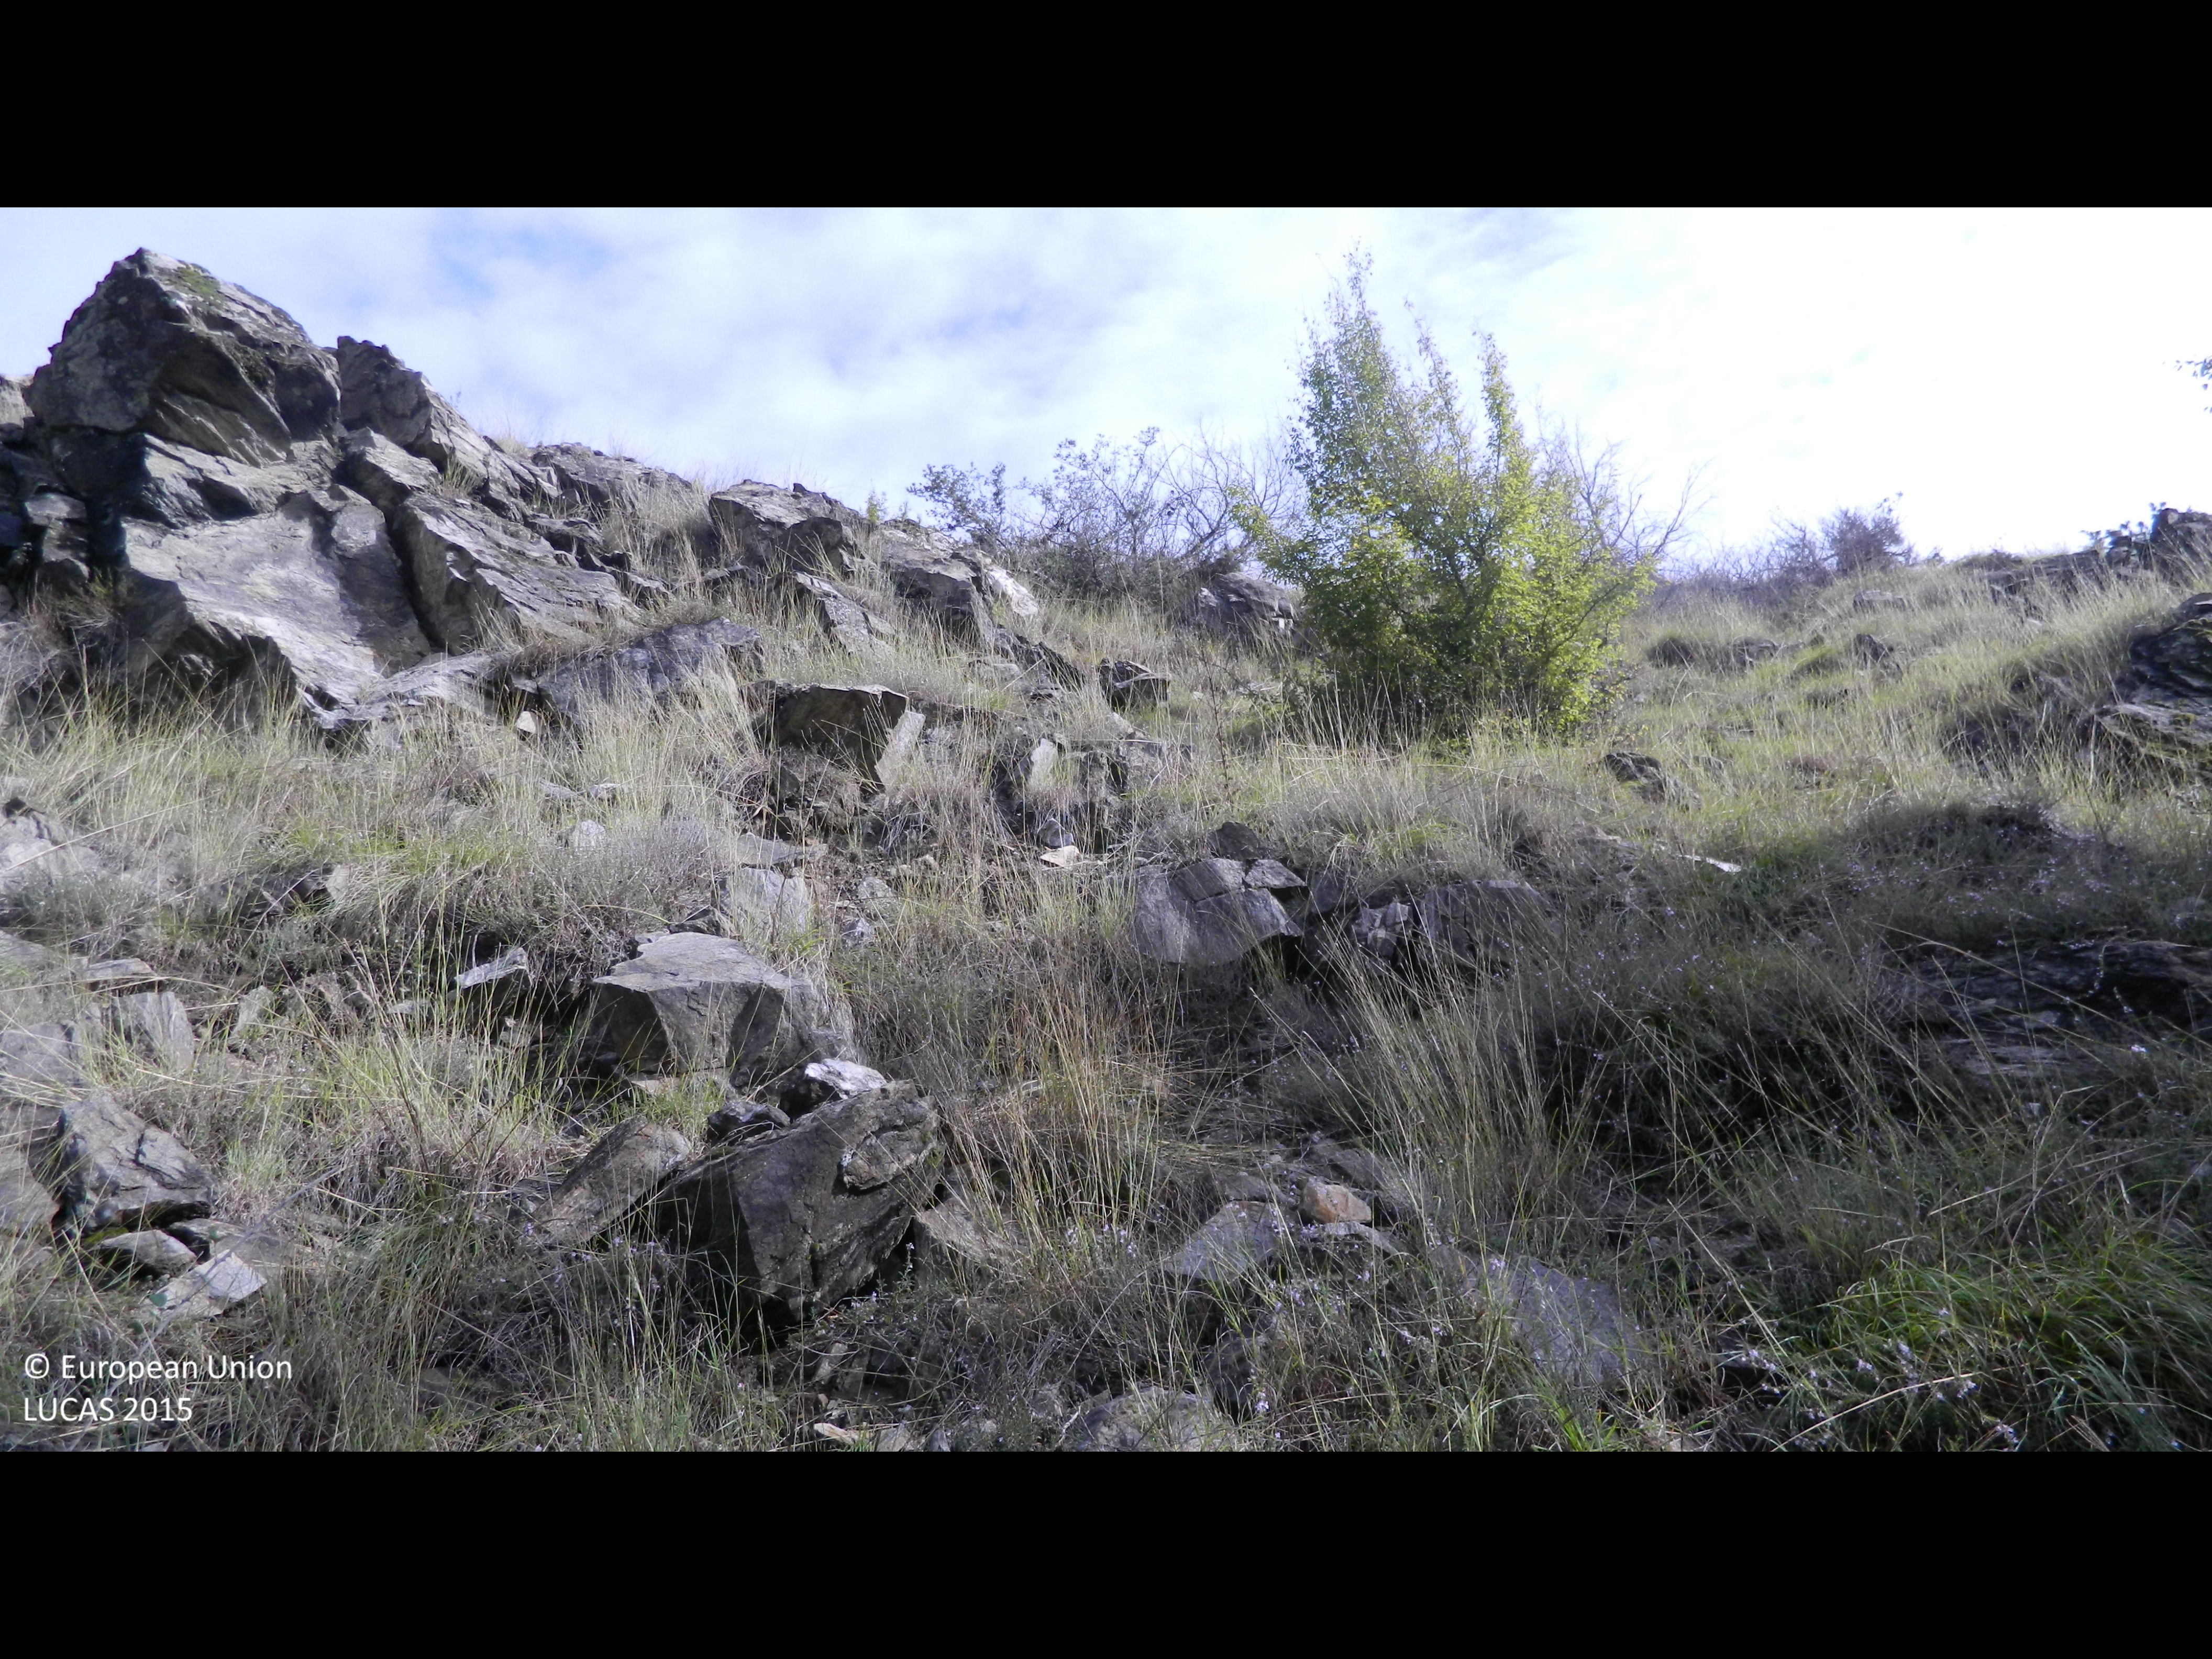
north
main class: Shrubland
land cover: Shrubland with sparse tree cover
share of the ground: > 75 %
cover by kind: shrubs 70 %, unconsolidated bare surface 15 %, herbaceous plants 10 %, broadleaved forest trees 5 %
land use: Abandoned areas
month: September
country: BG
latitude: 41.4741
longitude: 24.0057
